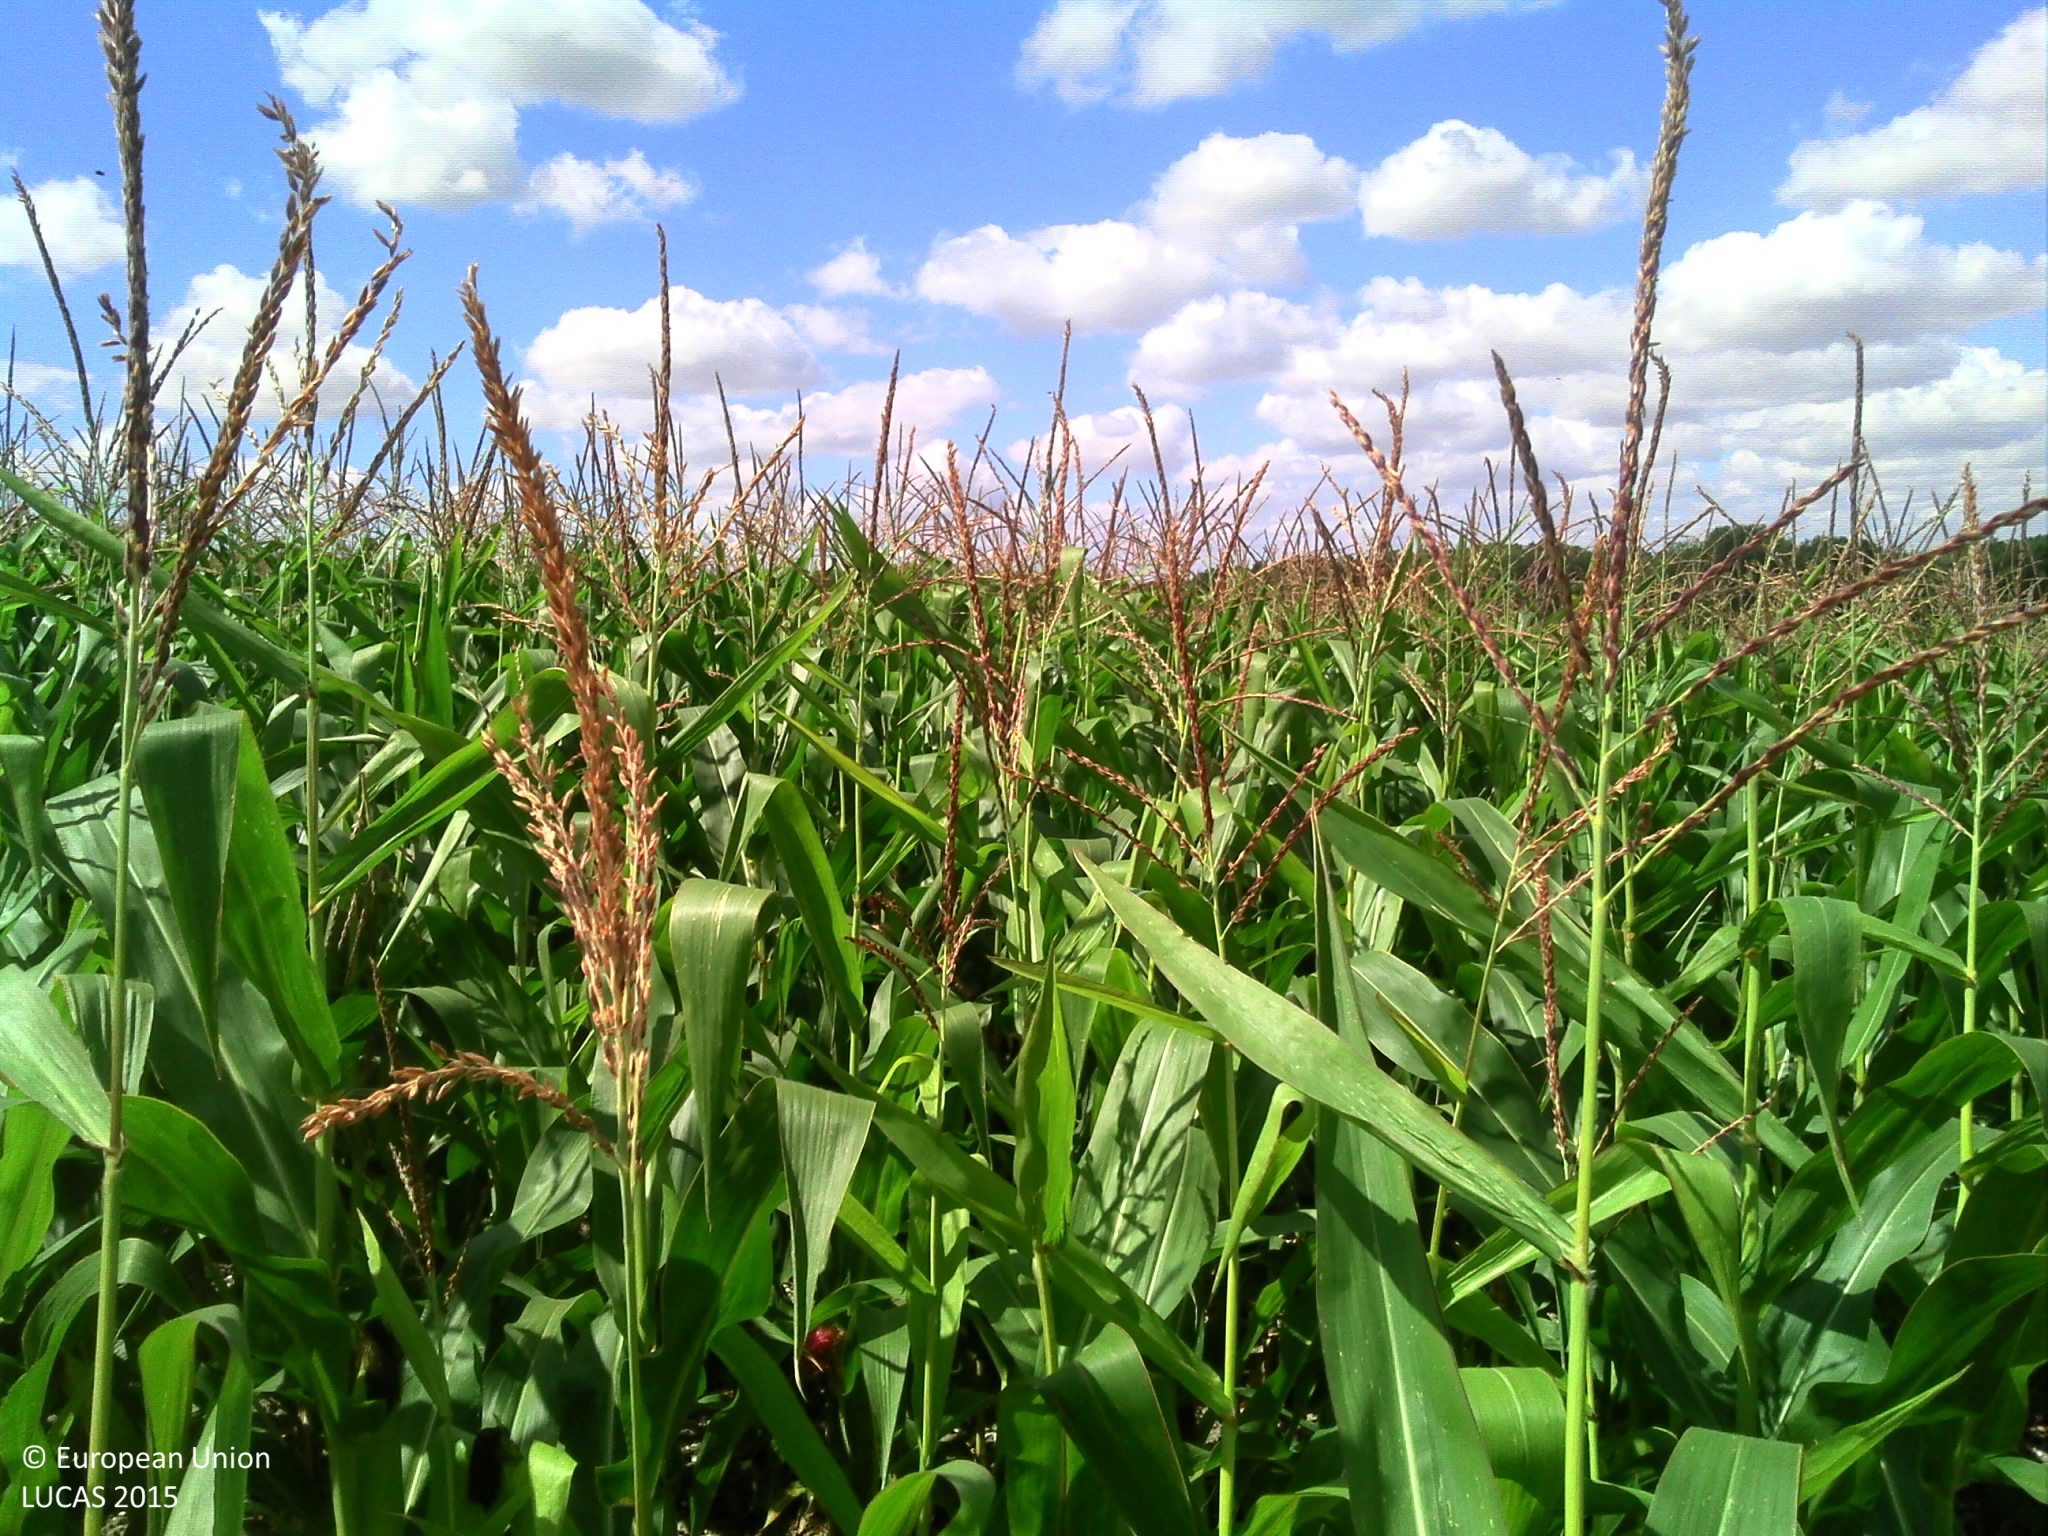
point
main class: Cropland
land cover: Maize
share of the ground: > 75 %
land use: Agriculture (excluding fallow land and kitchen gardens)
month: July
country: FR
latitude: 47.0257
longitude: 0.4142
